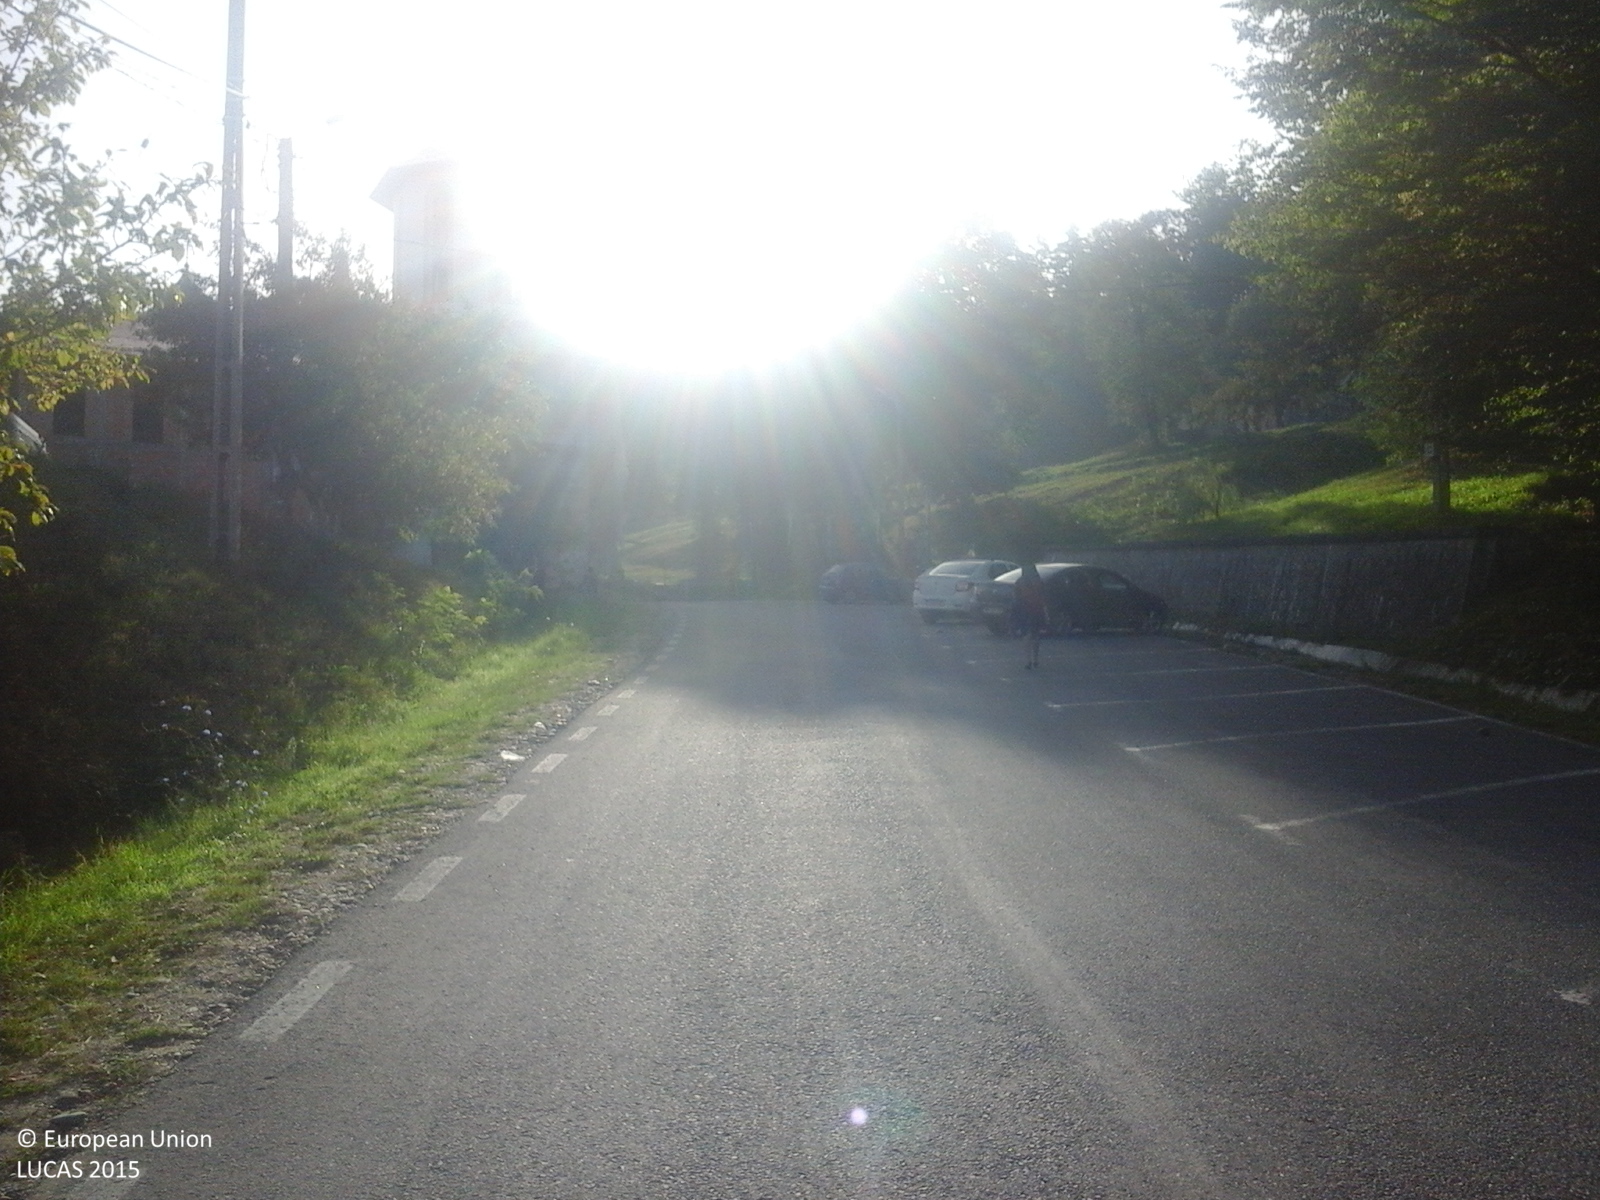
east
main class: Cropland
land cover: Nuts trees
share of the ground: > 75 %
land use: Agriculture (excluding fallow land and kitchen gardens)
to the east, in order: Grass margins; Nuts trees; Artificial constructions in urban areas; Spontaneously vegetated surfaces; Artificial constructions in urban areas
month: September
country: RO
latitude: 47.0019
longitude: 23.9542
